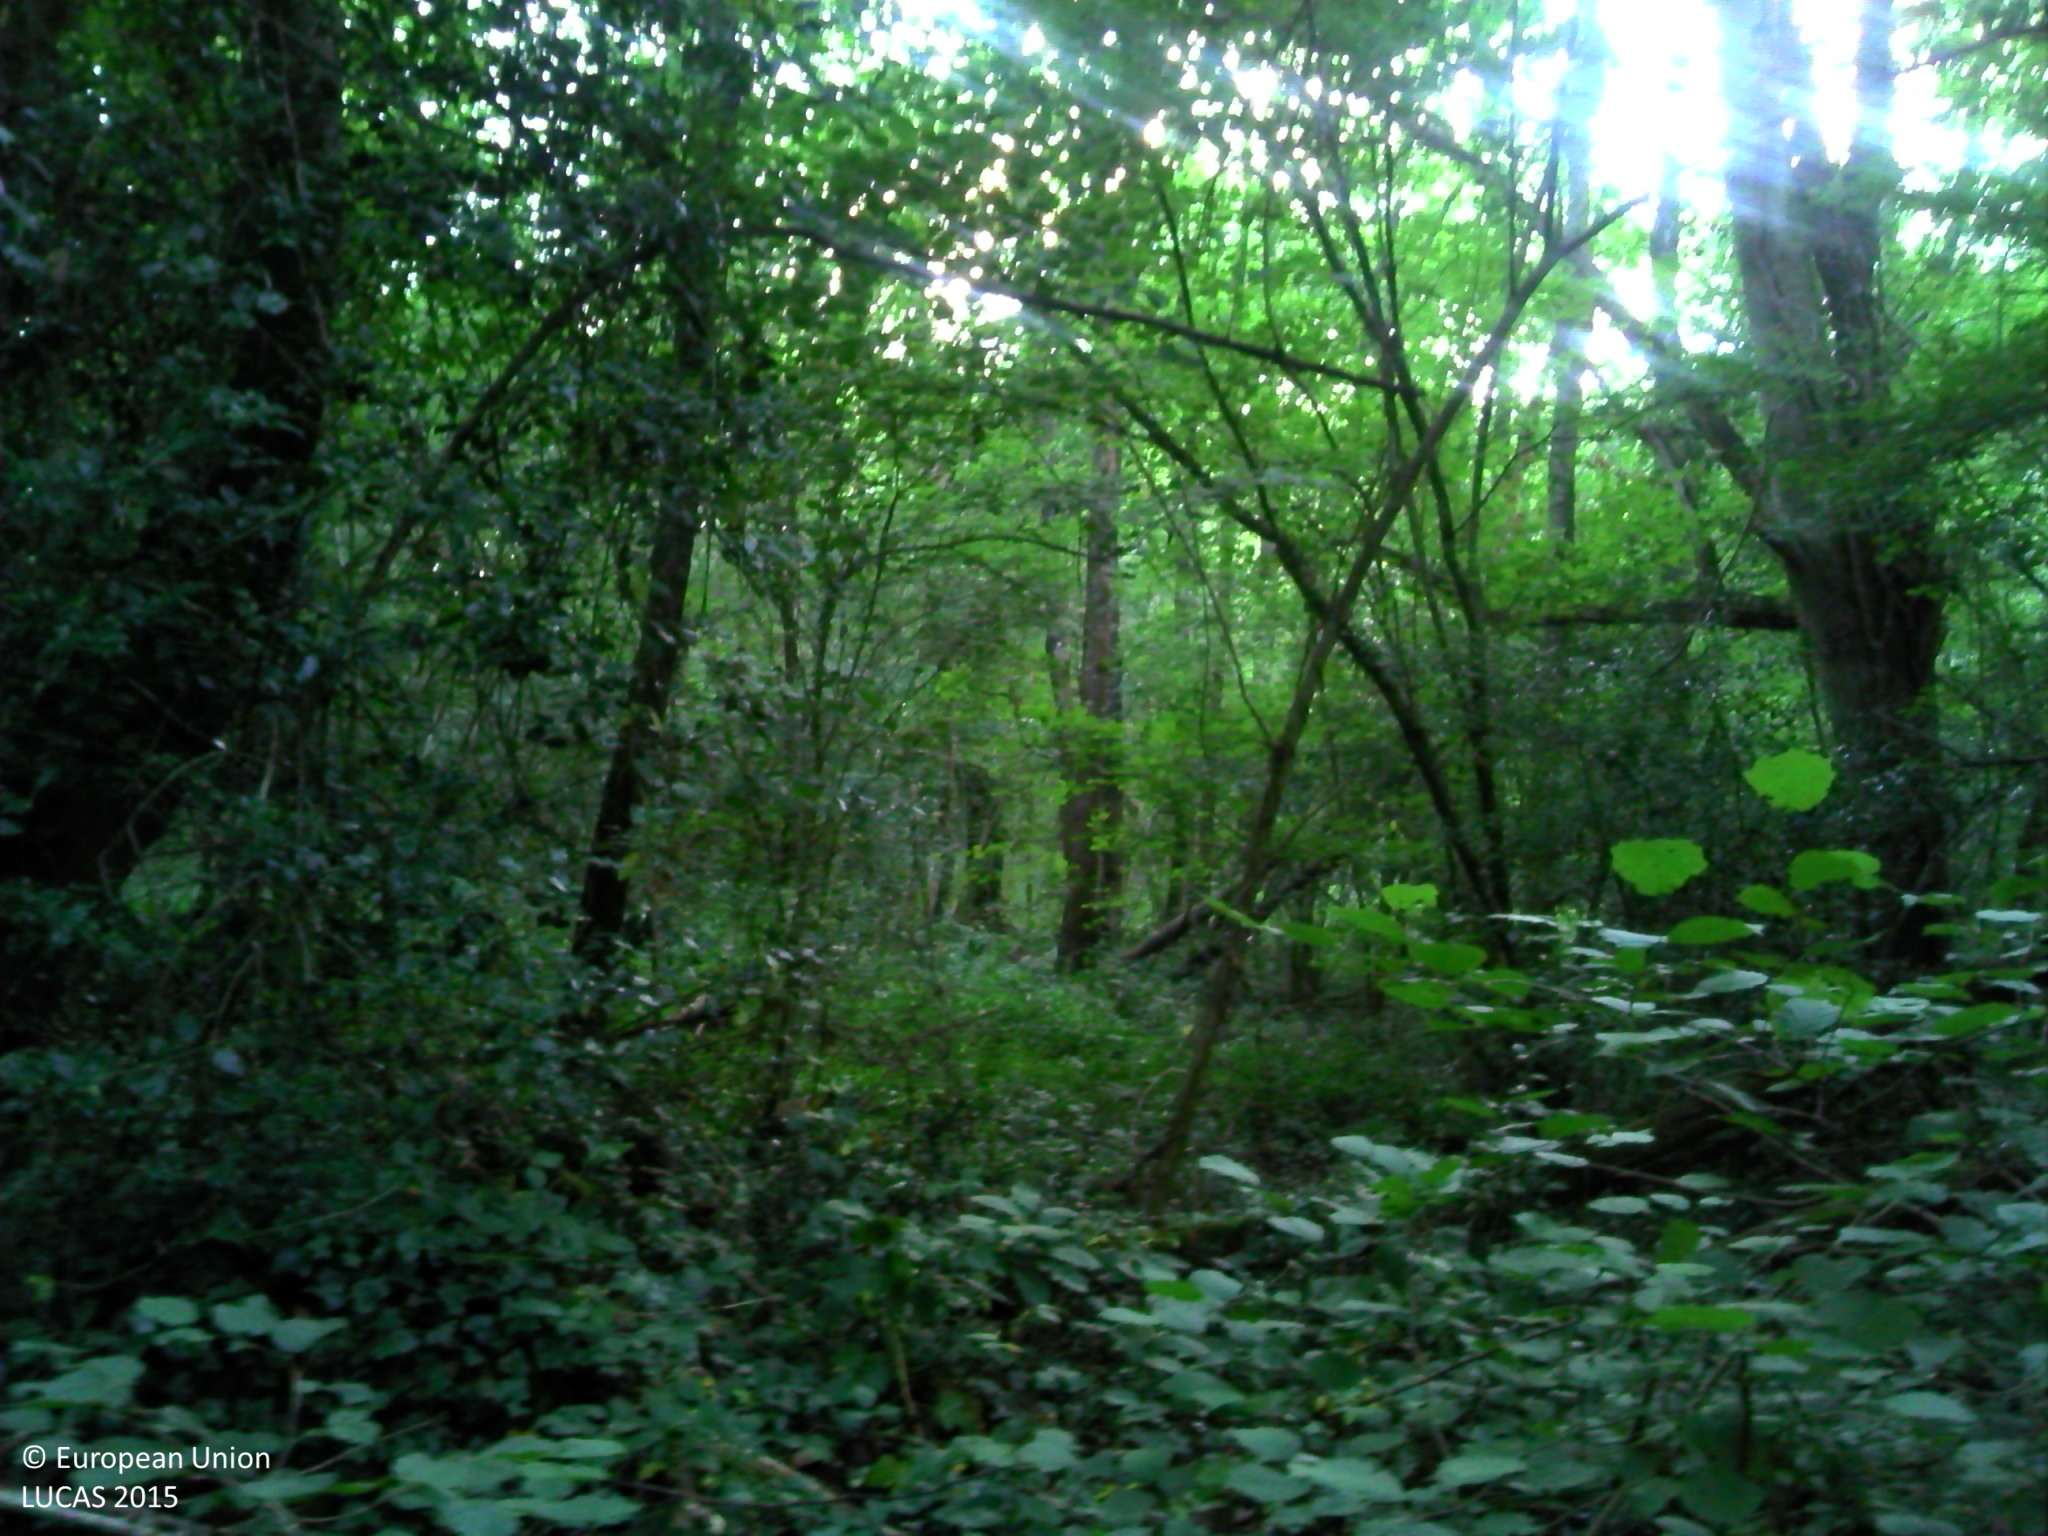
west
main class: Woodland
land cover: Broadleaved woodland
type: thermophilous deciduous forest
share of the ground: > 75 %
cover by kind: broadleaved forest trees 90 %, shrubs 5 %, herbaceous plants 5 %
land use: Forestry
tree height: > 5 m
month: August
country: FR
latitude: 43.3576
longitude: -1.0561
